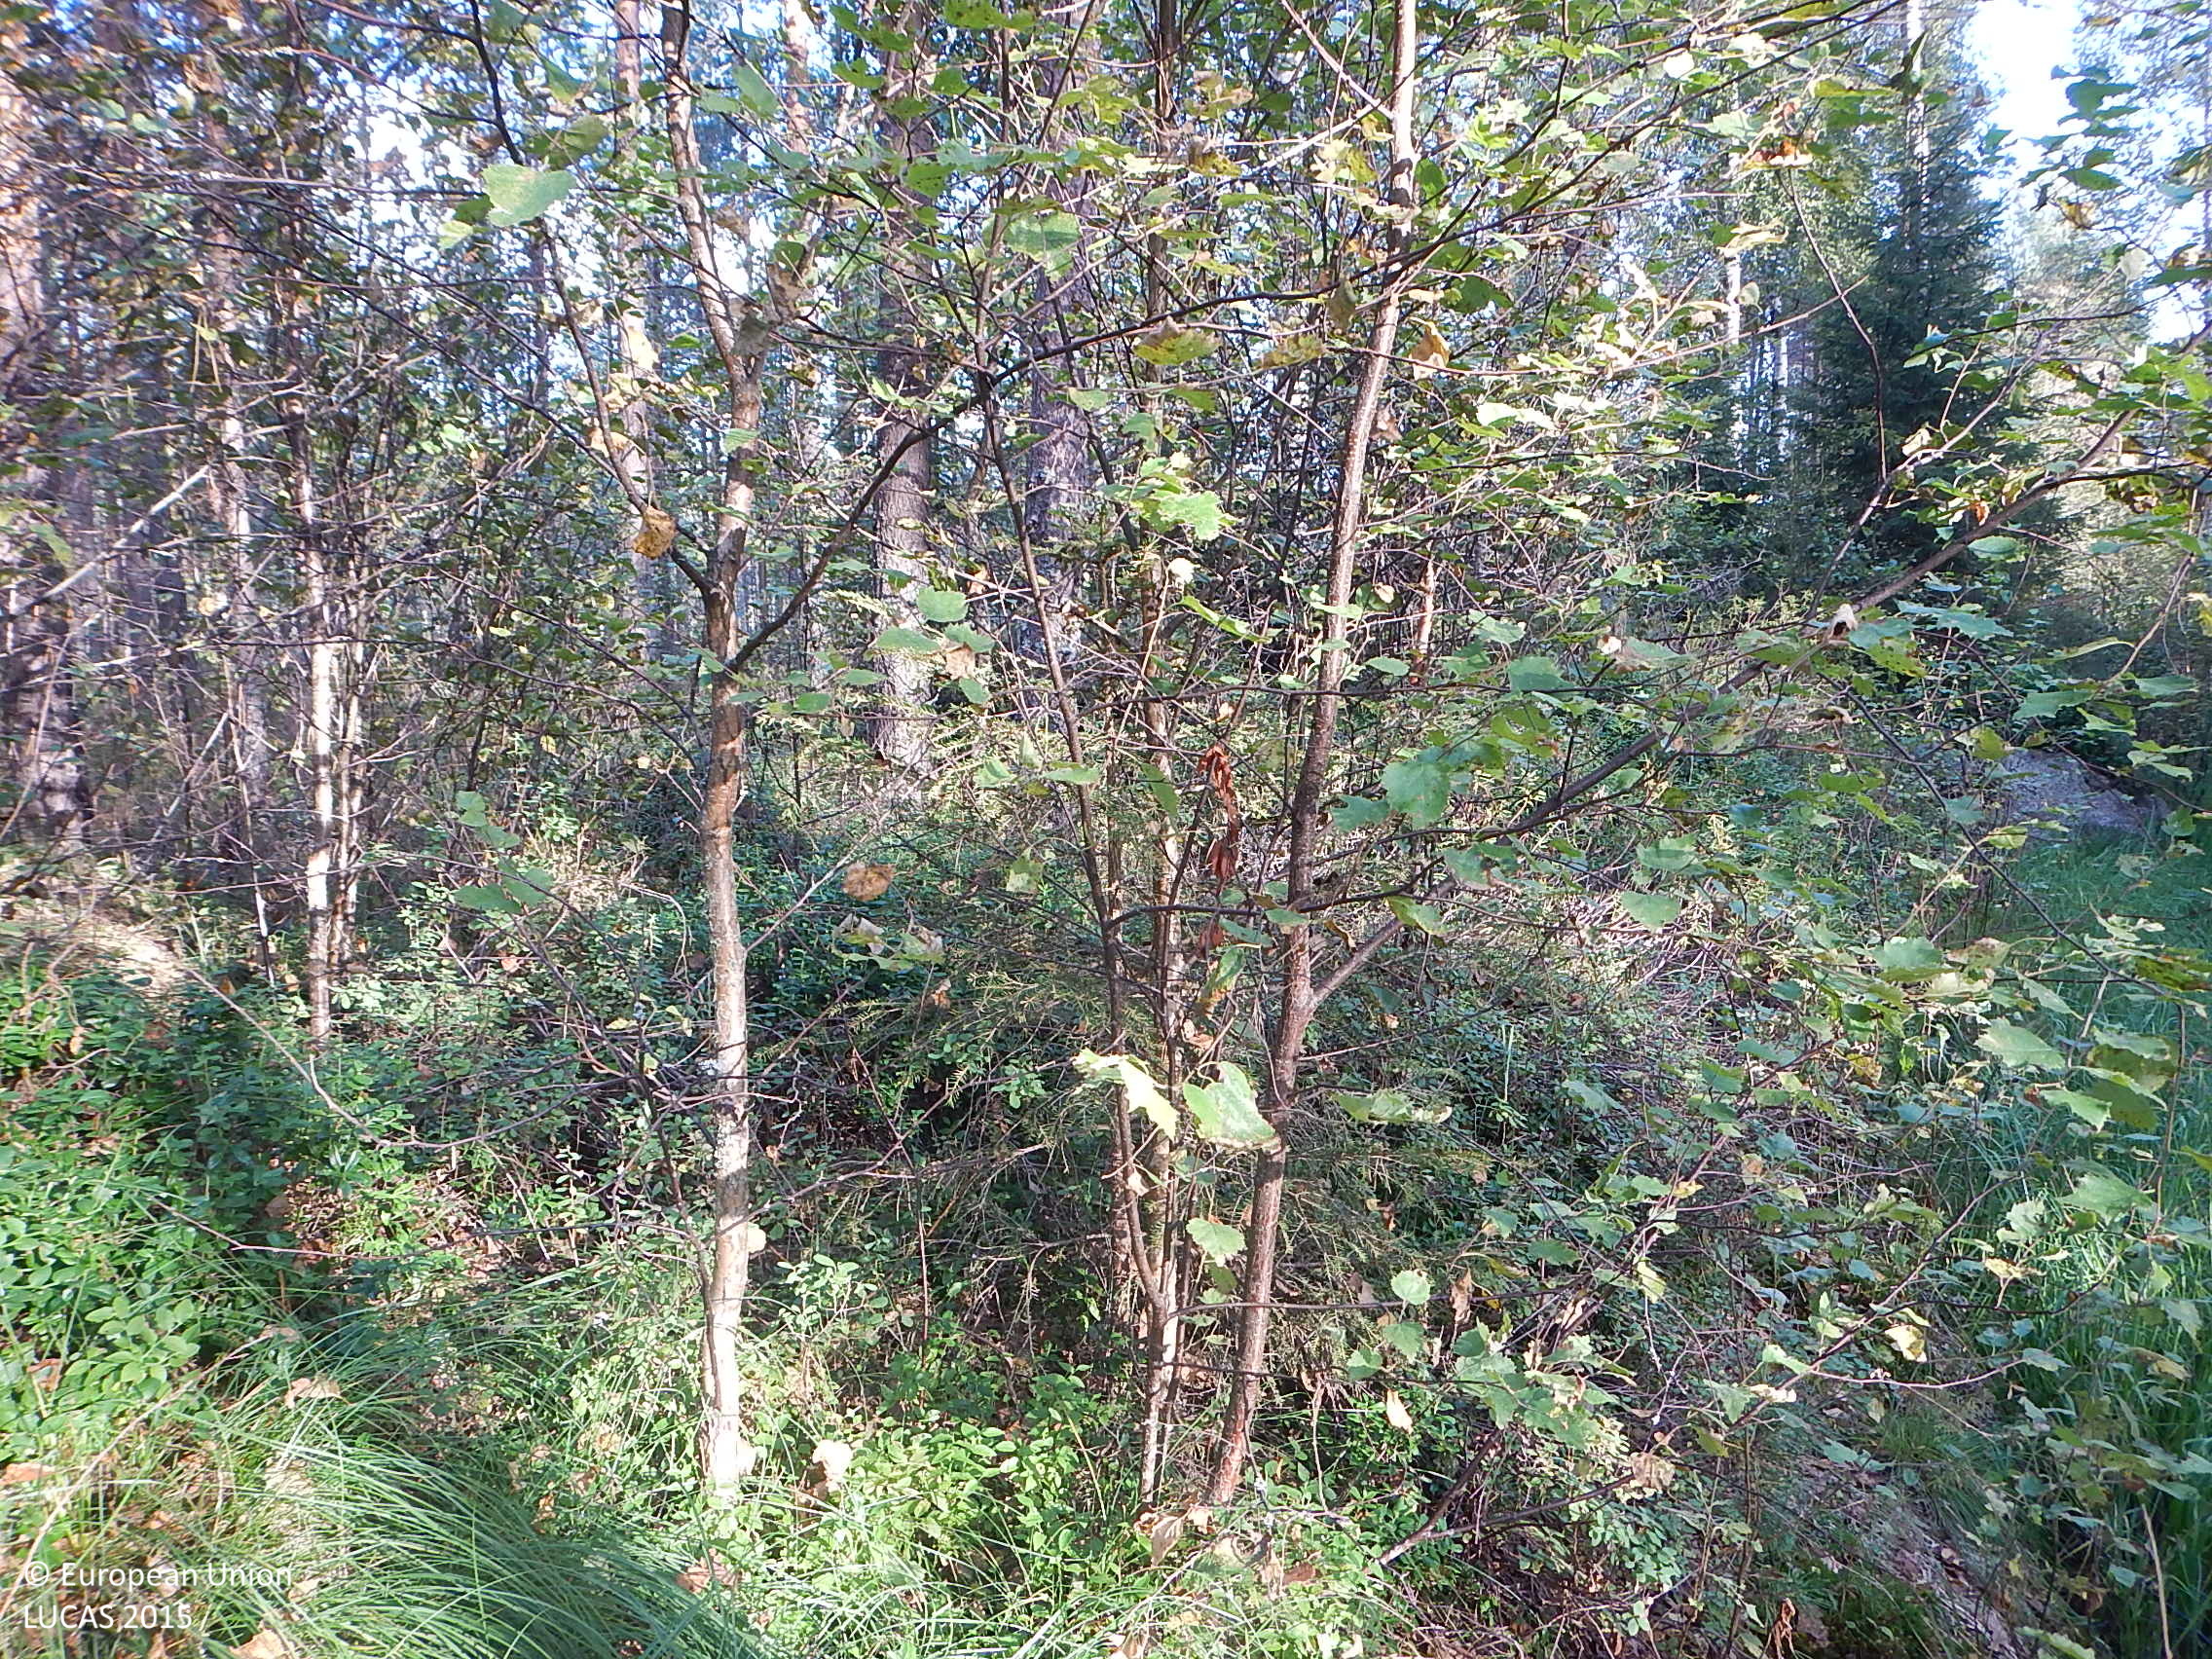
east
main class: Woodland
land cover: Other mixed woodland
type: boreal forest
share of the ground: > 75 %
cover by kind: coniferous forest trees 55 %, broadleaved forest trees 25 %, shrubs 10 %, herbaceous plants 5 %, lichens and mosses 5 %
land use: Forestry
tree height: > 5 m
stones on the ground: < 10 %
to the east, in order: Other mixed woodland; Ditches and canals; Pine dominated coniferous woodland; Tracks; Pine dominated coniferous woodland; Ditches and canals; Pine dominated coniferous woodland; Ditches and canals; Pine dominated coniferous woodland; Ditches and canals; Pine dominated coniferous woodland; Pine dominated mixed woodland
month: September
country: FI
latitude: 61.5740
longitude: 22.3196
